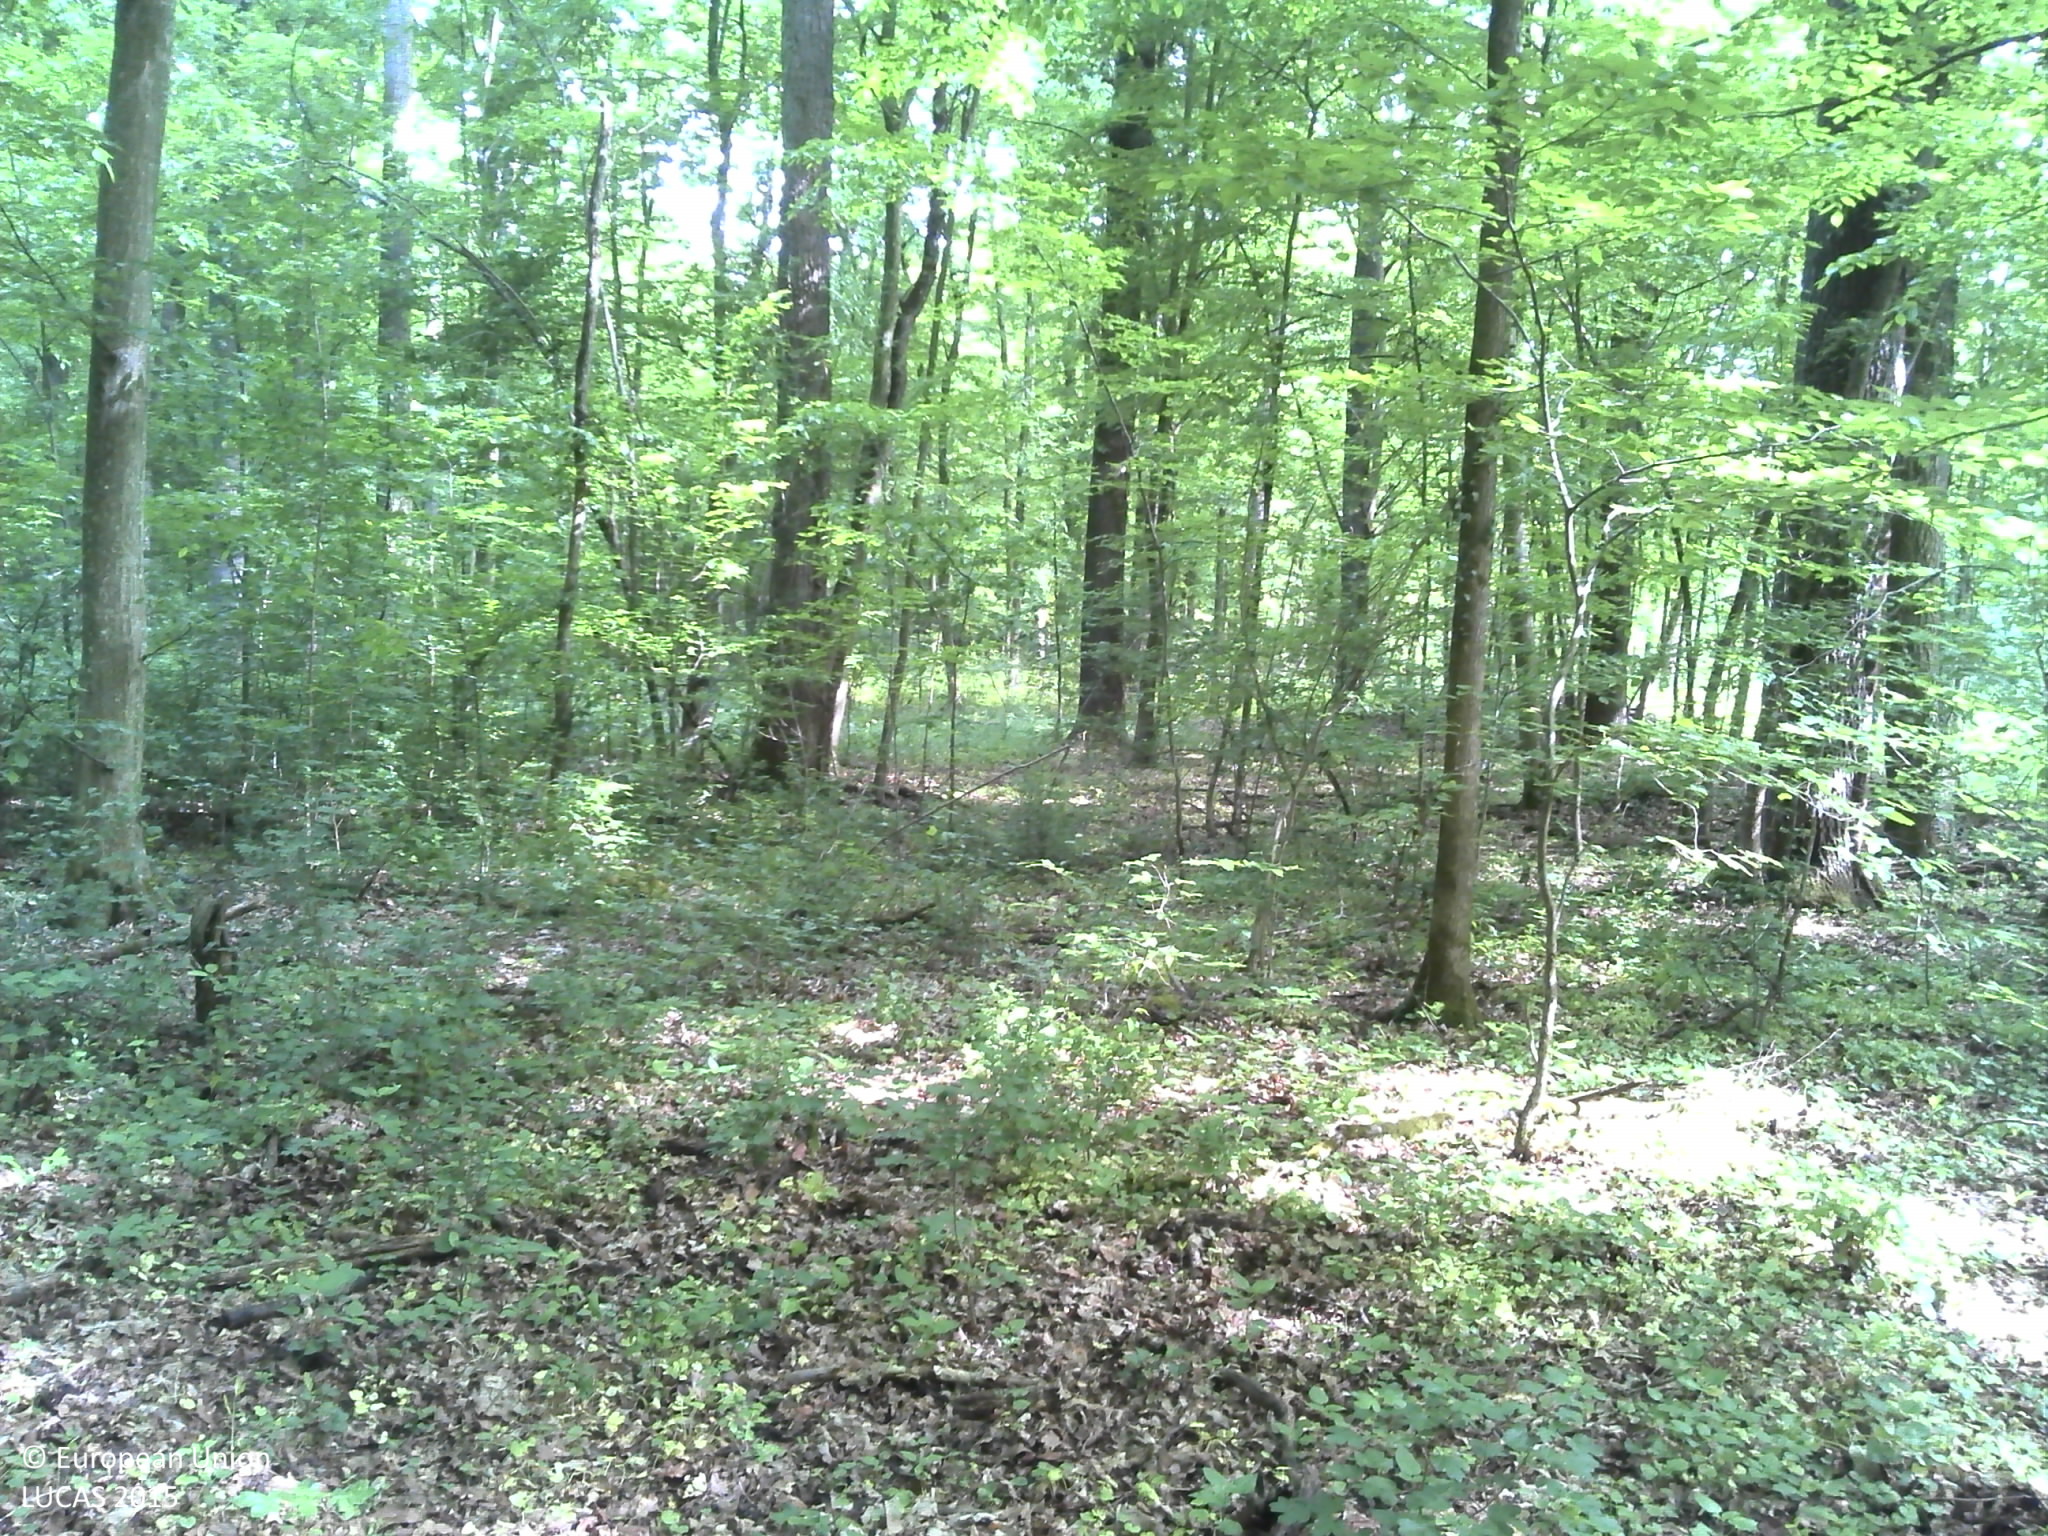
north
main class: Woodland
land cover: Broadleaved woodland
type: mesophytic deciduous forest
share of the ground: > 75 %
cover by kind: broadleaved forest trees 100 %
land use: Forestry
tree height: > 5 m
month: May
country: HR
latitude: 45.1516
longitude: 18.6166
